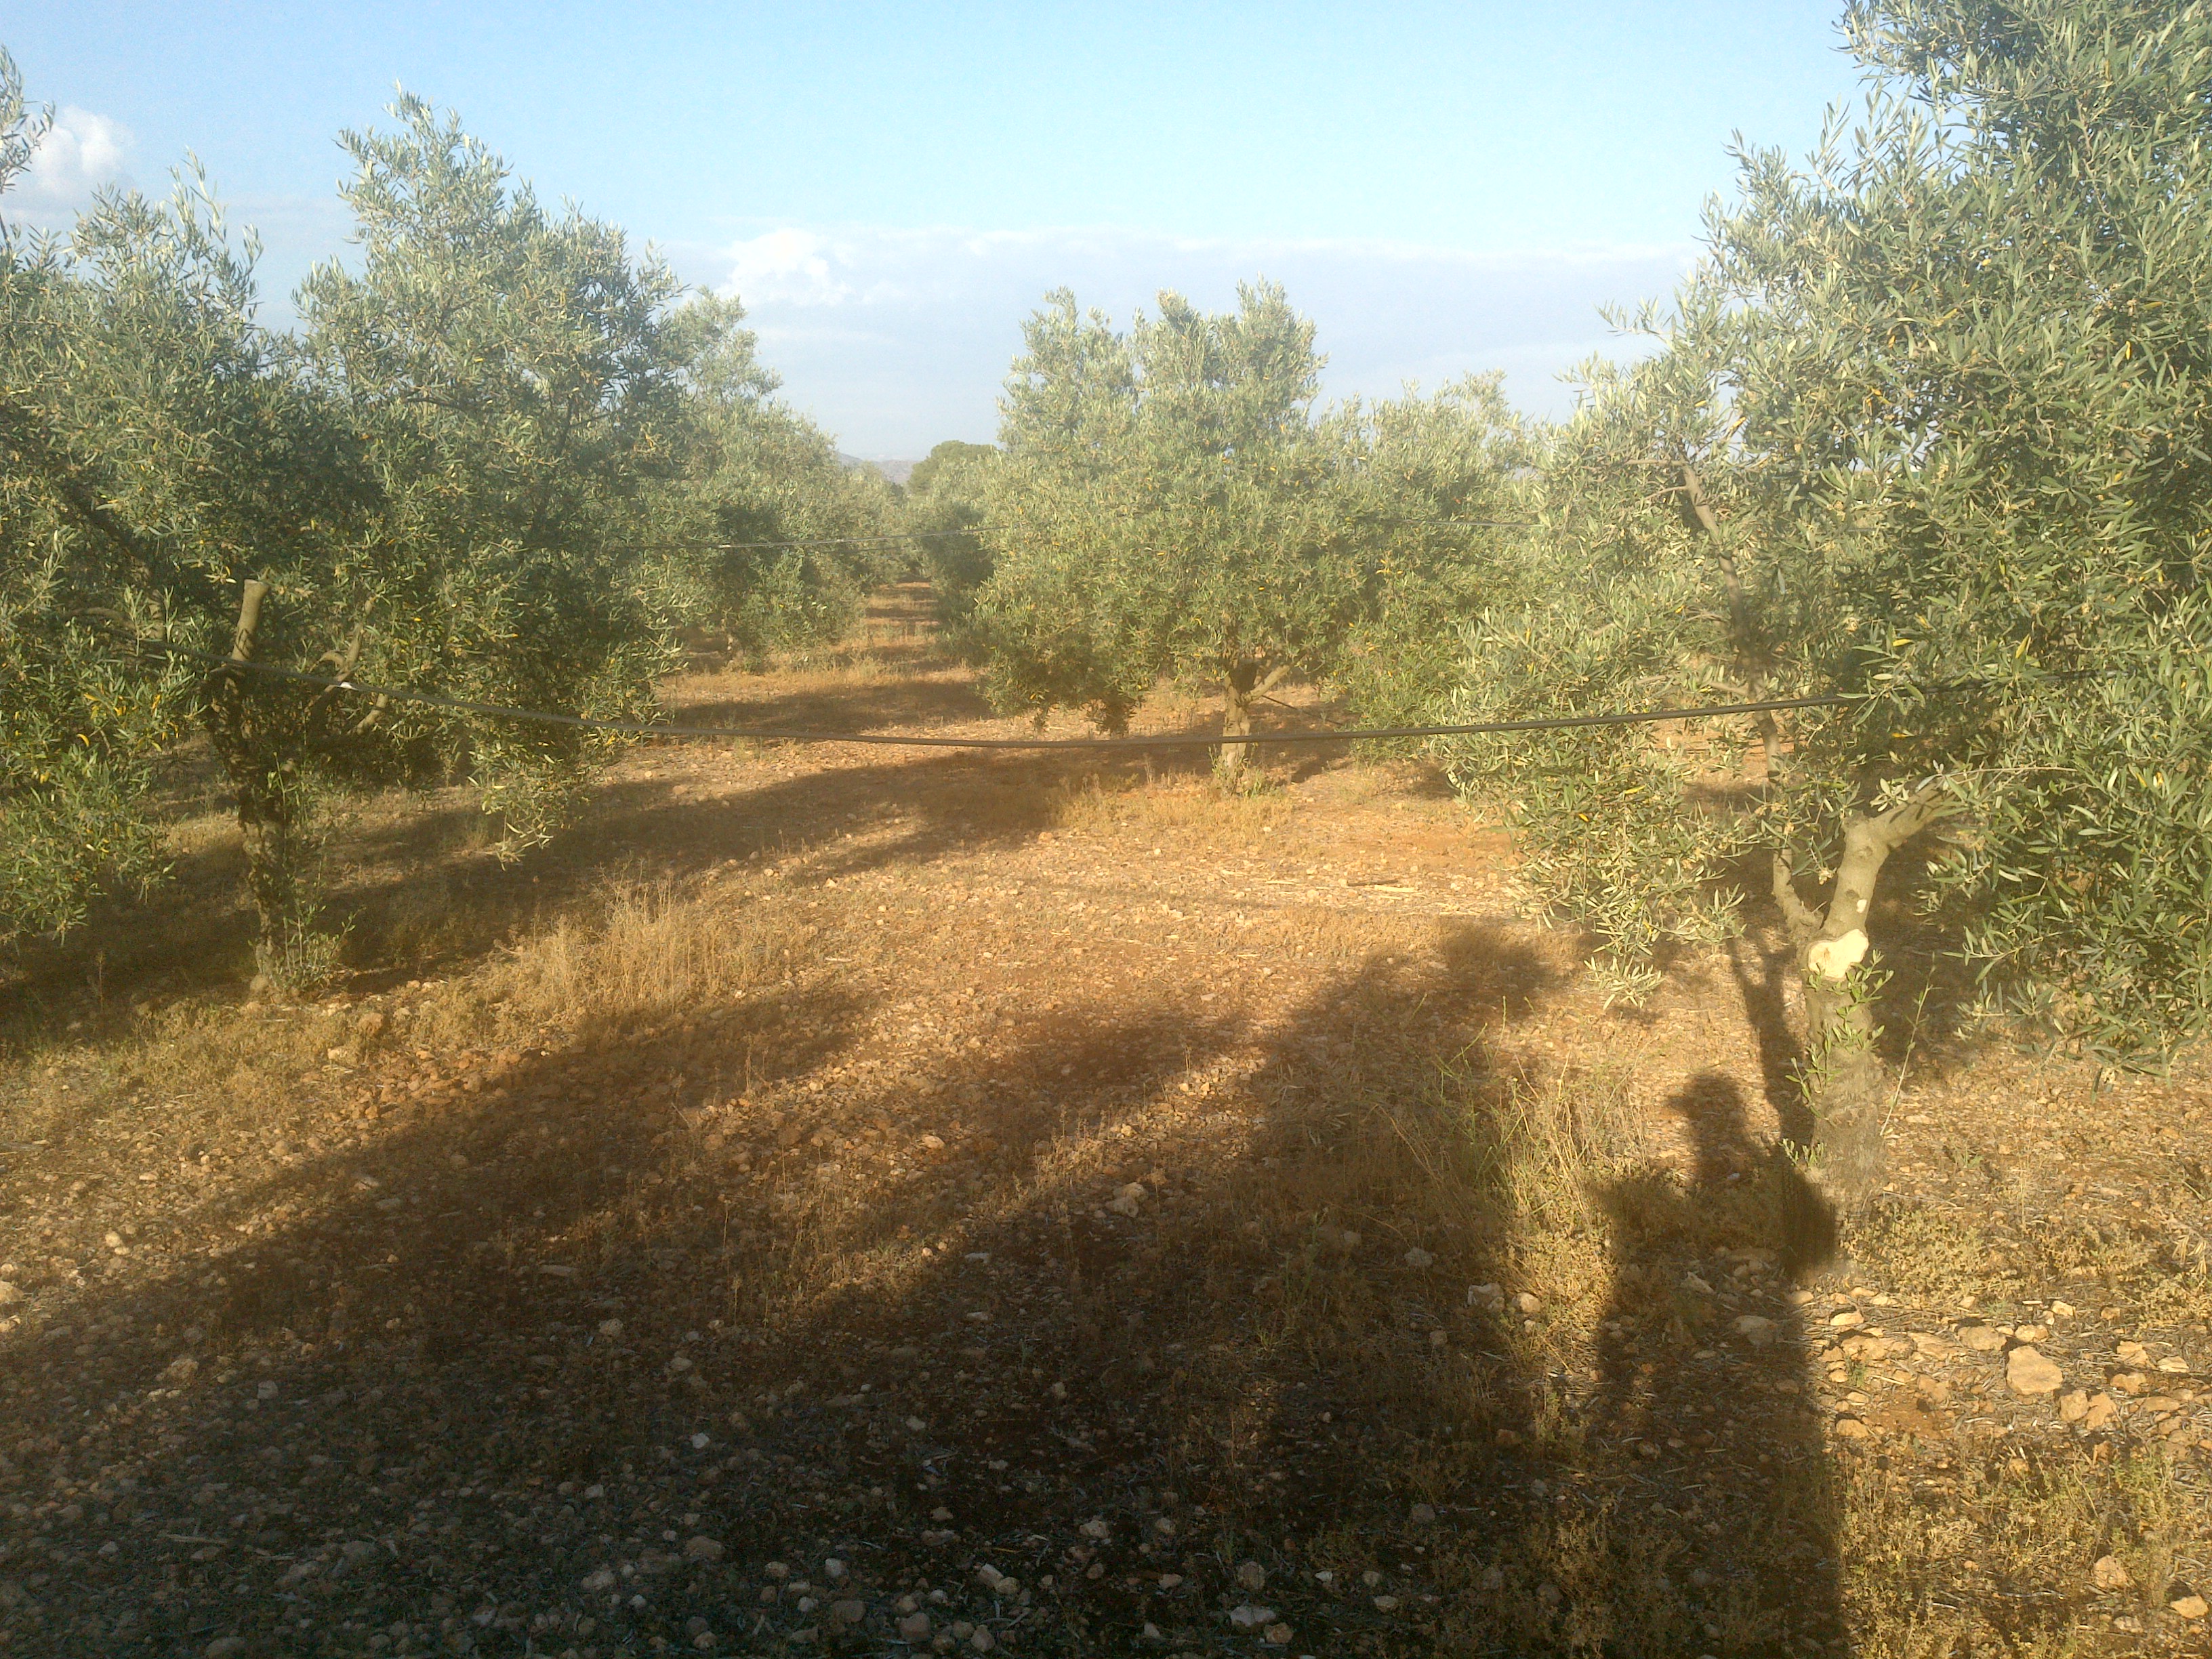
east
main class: Cropland
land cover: Olive groves
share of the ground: 50 - 75 %
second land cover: Other bare soil
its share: > 75 %
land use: Agriculture (excluding fallow land and kitchen gardens)
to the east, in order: Olive groves; Other bare soil; Tracks; Olive groves
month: May
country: ES
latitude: 37.3508
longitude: -4.8285
